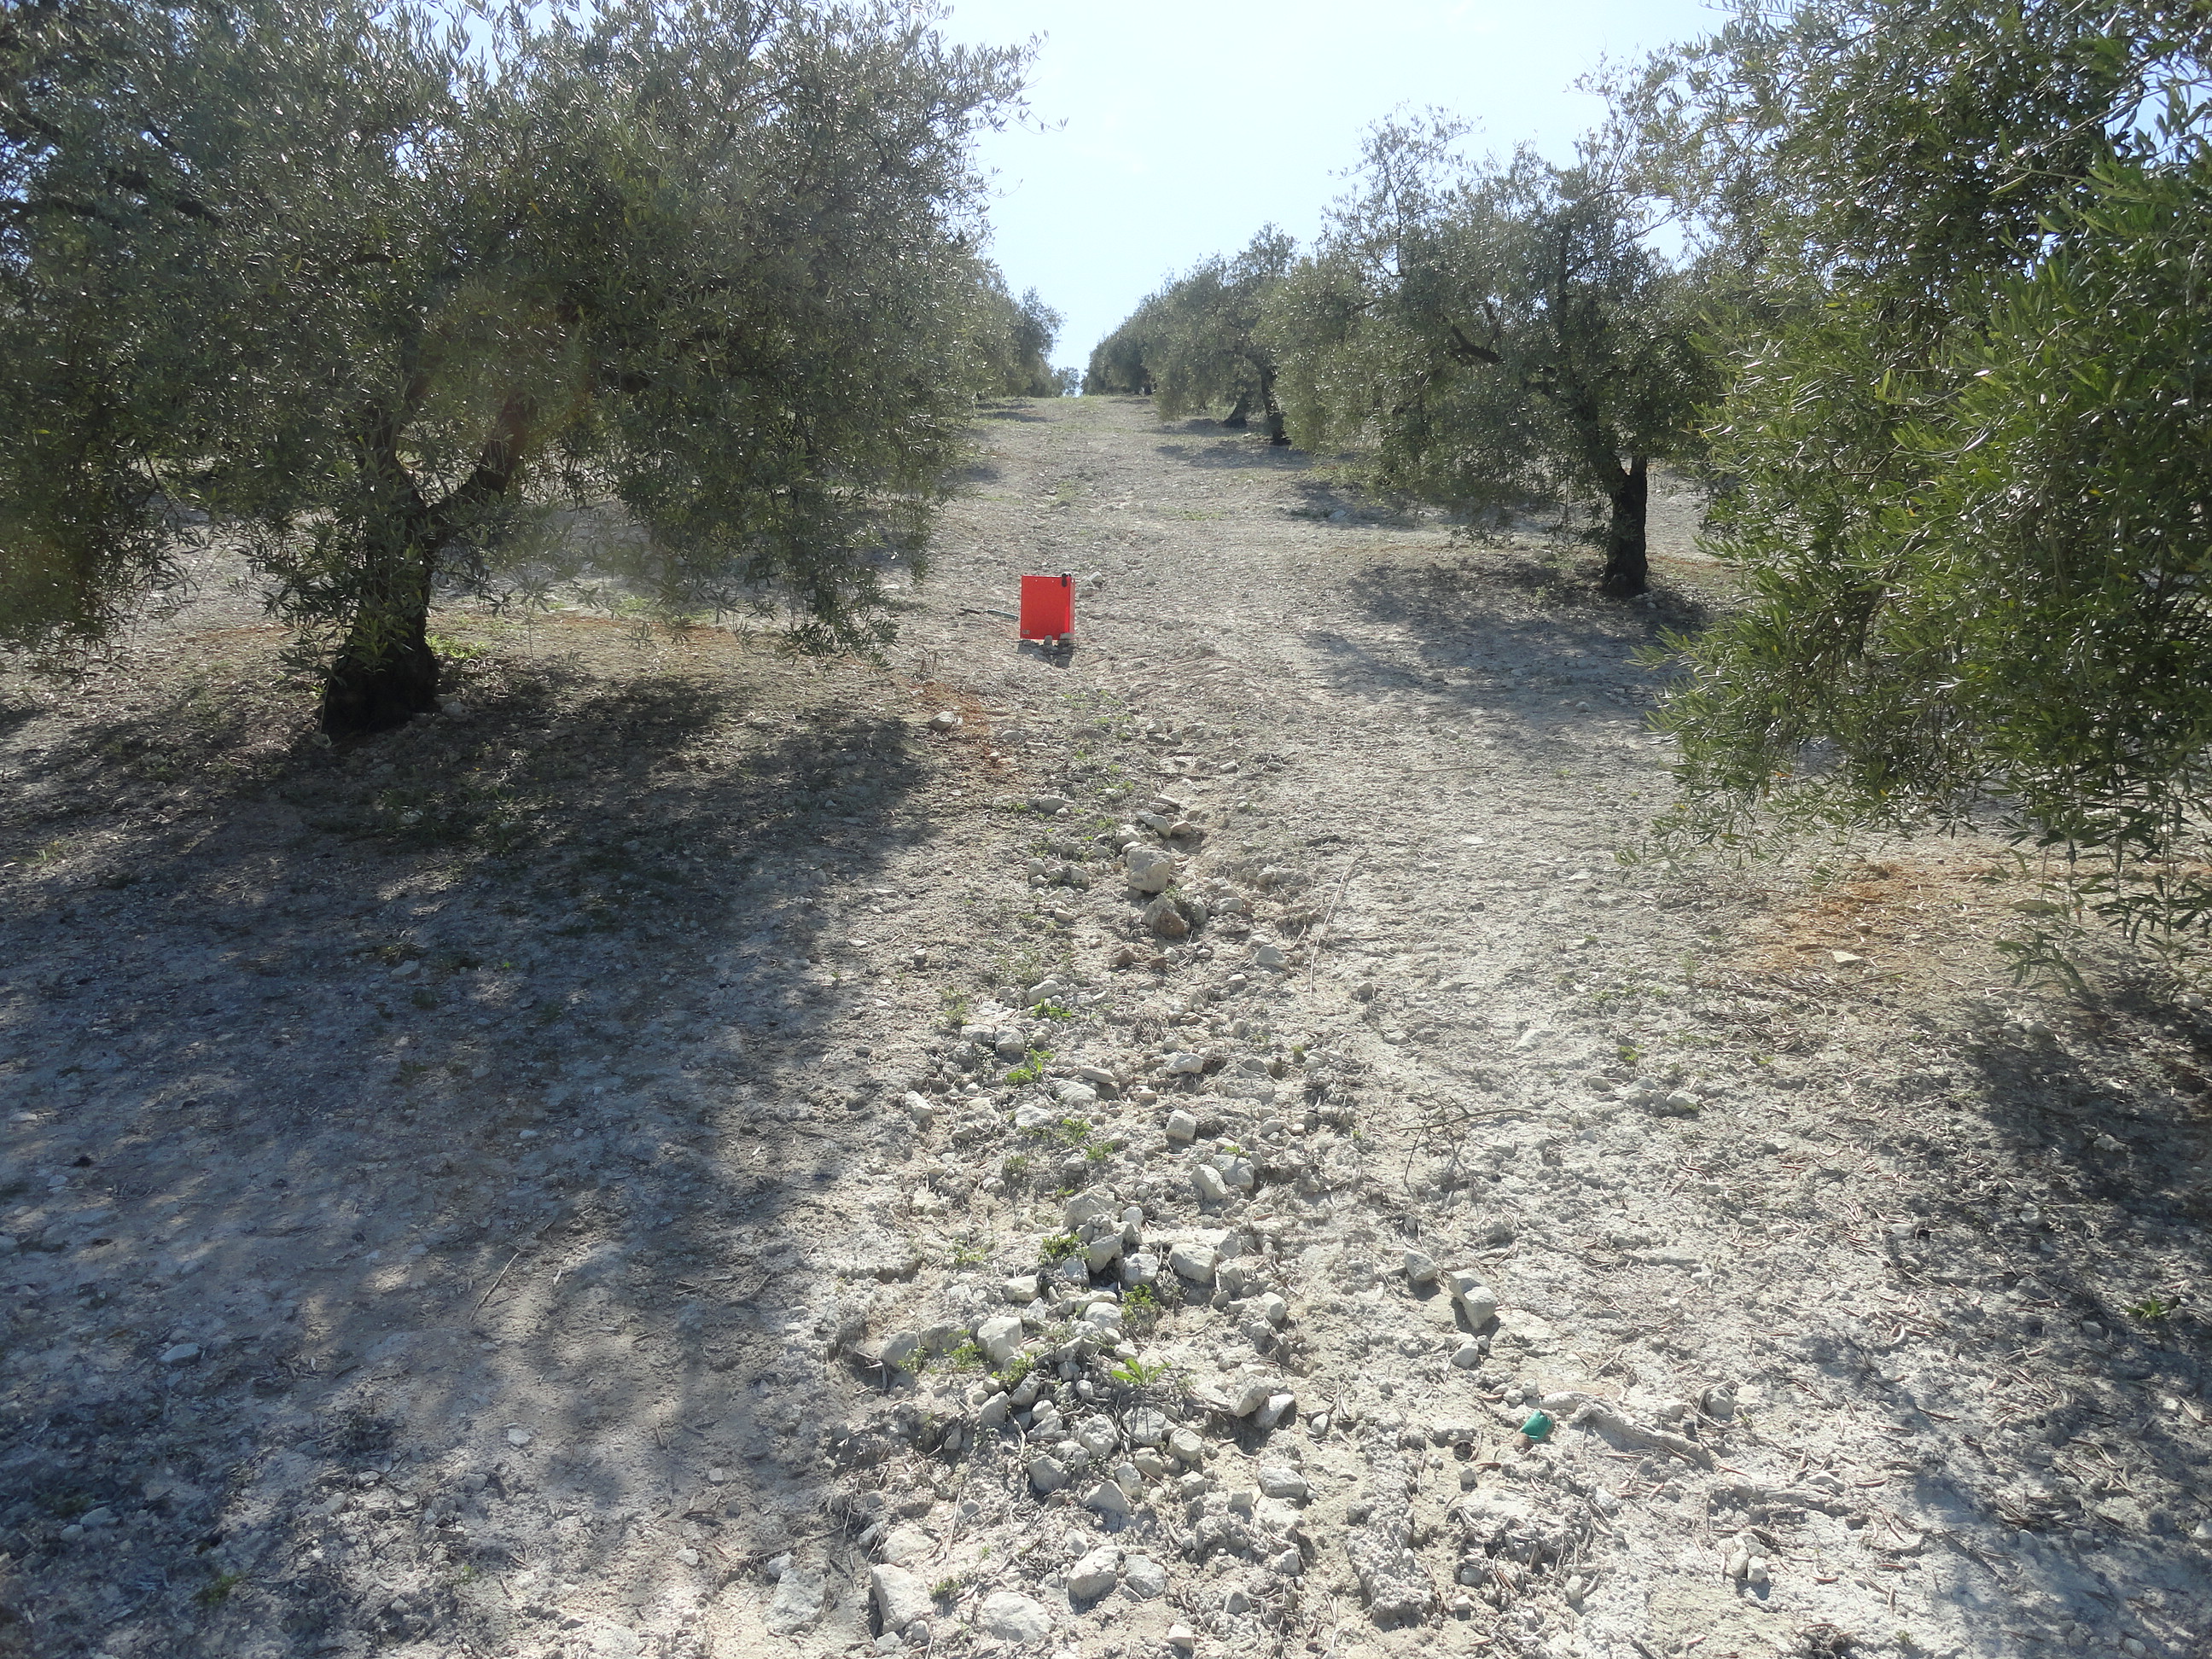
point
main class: Cropland
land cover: Olive groves
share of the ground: 50 - 75 %
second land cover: Other bare soil
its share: > 75 %
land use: Agriculture (excluding fallow land and kitchen gardens)
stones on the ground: 10 - 25 %
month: April
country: ES
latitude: 37.5341
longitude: -4.4787
